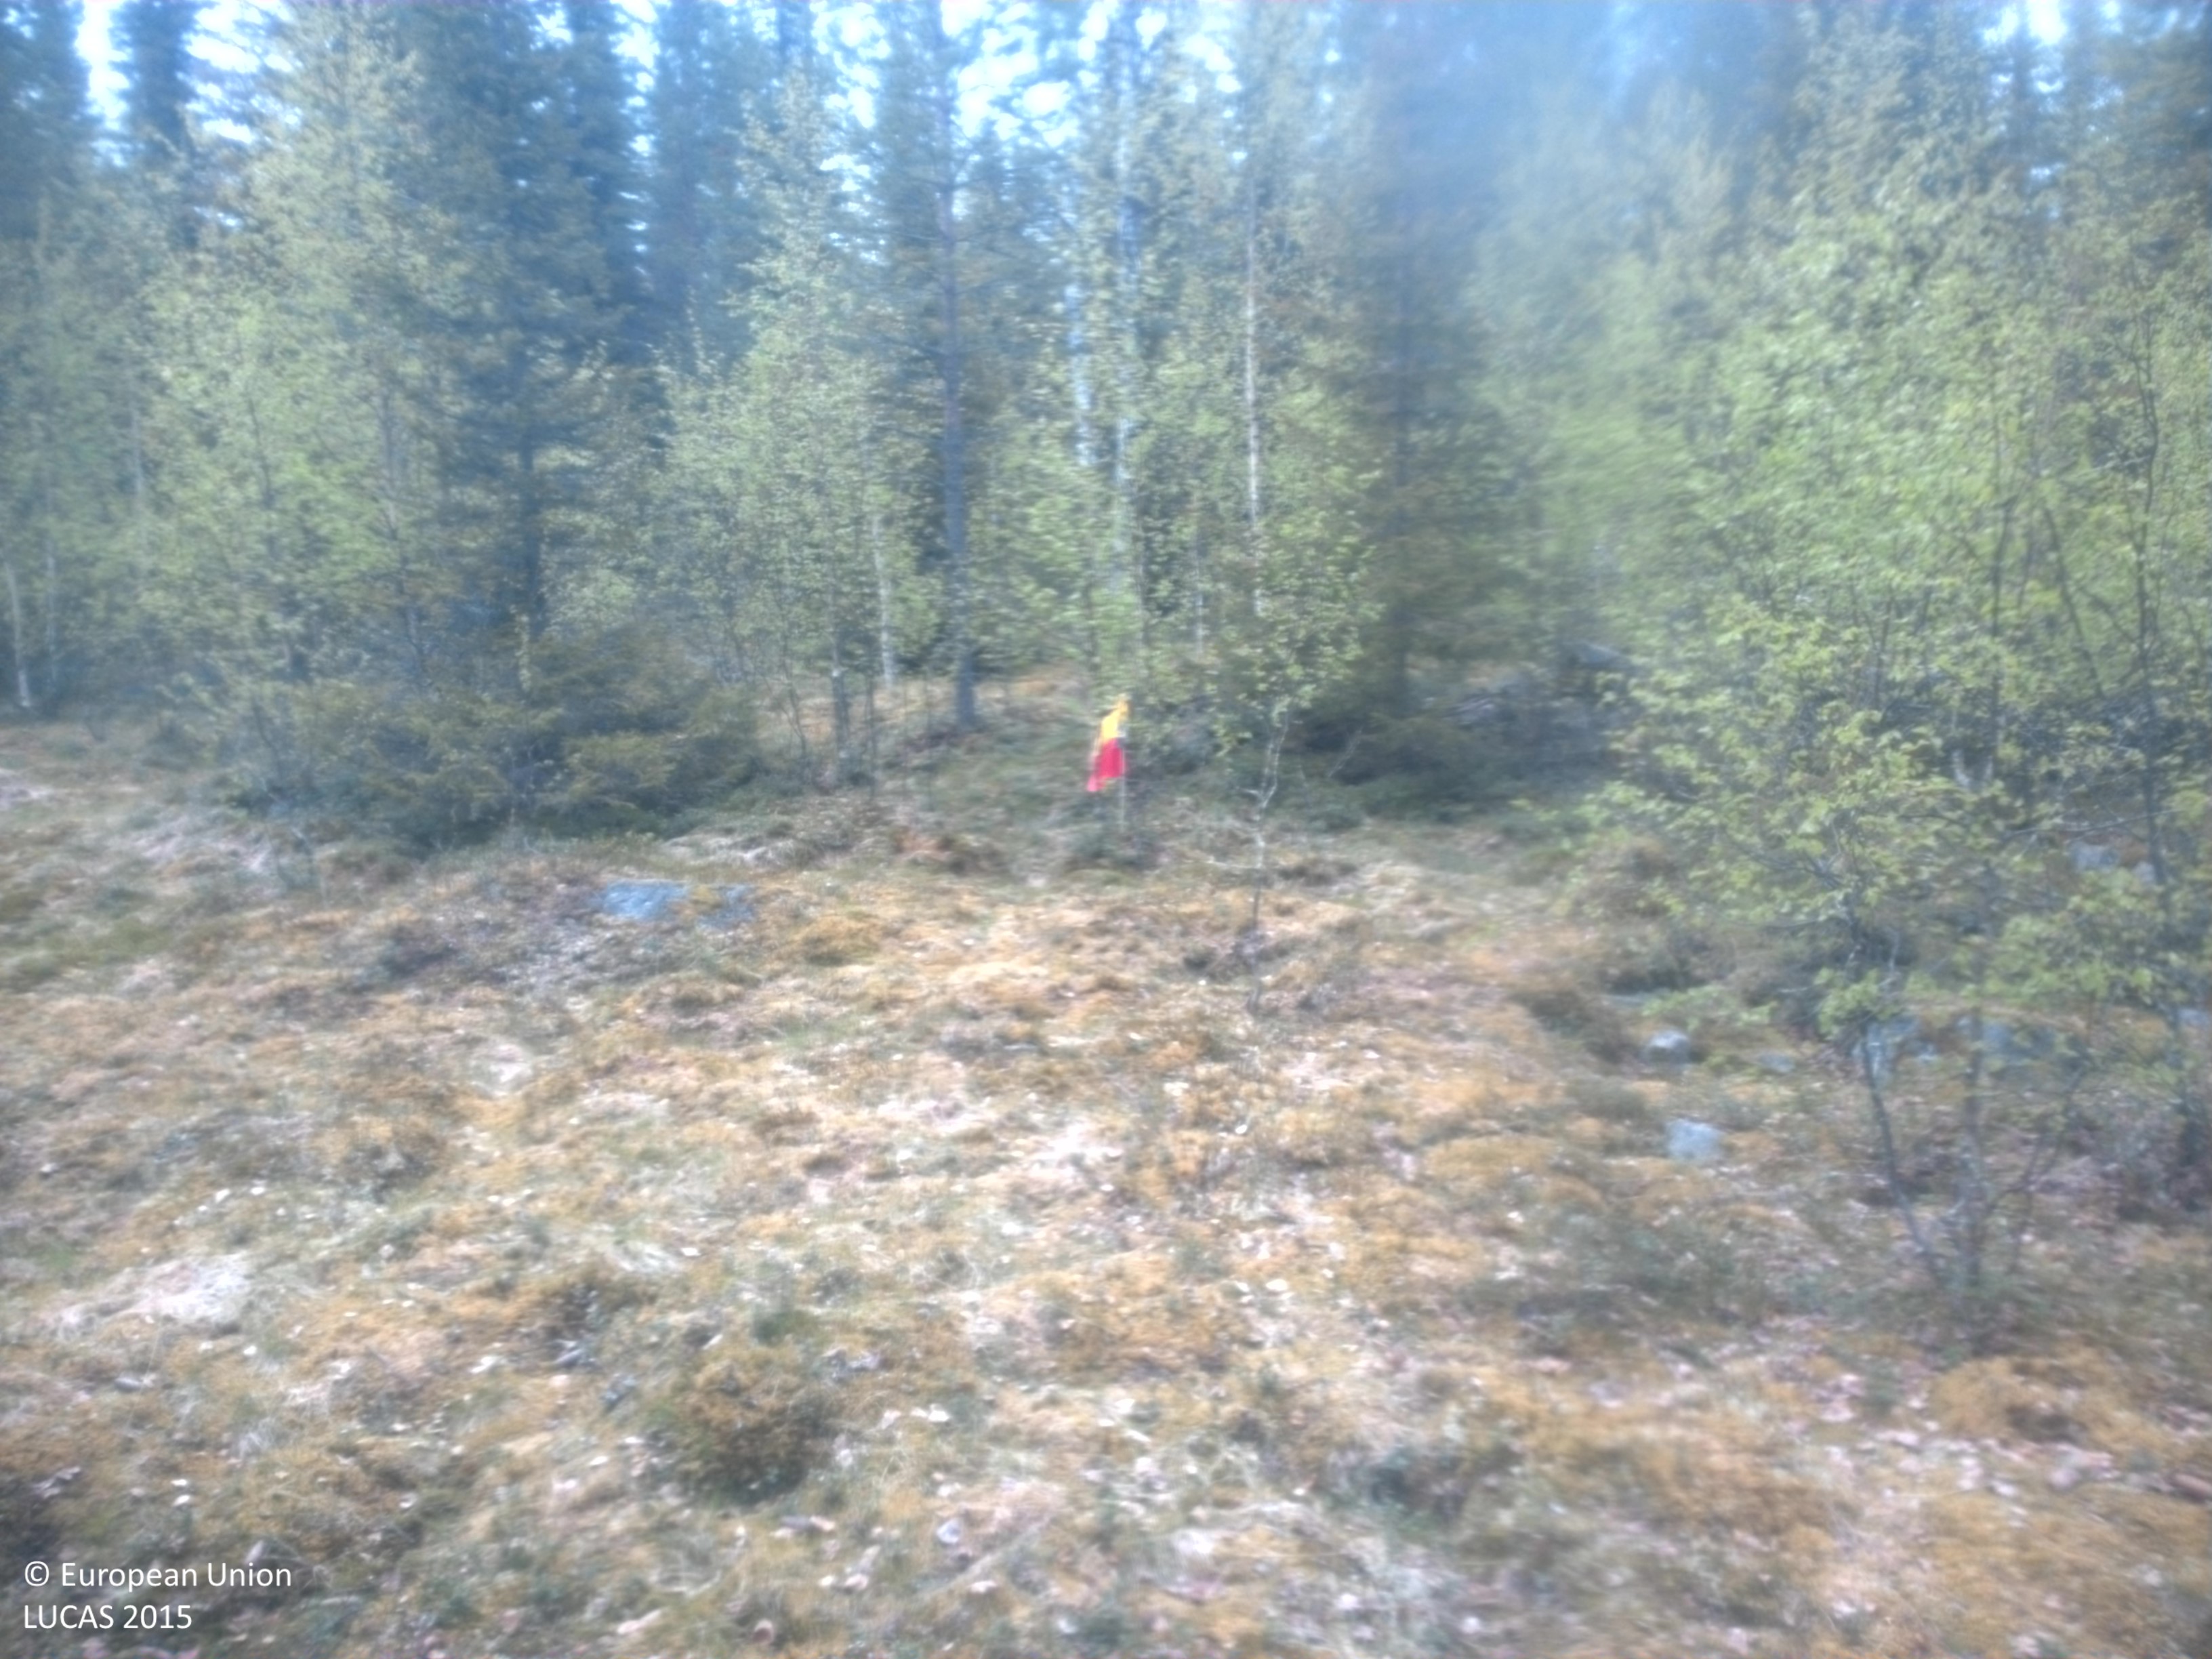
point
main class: Woodland
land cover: Broadleaved woodland
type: boreal forest
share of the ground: 25 - 50 %
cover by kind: broadleaved forest trees 35 %, herbaceous plants 35 %, lichens and mosses 15 %, unconsolidated bare surface 10 %, coniferous forest trees 5 %
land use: Forestry
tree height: < 5 m
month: June
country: SE
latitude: 64.3906
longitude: 17.7440
